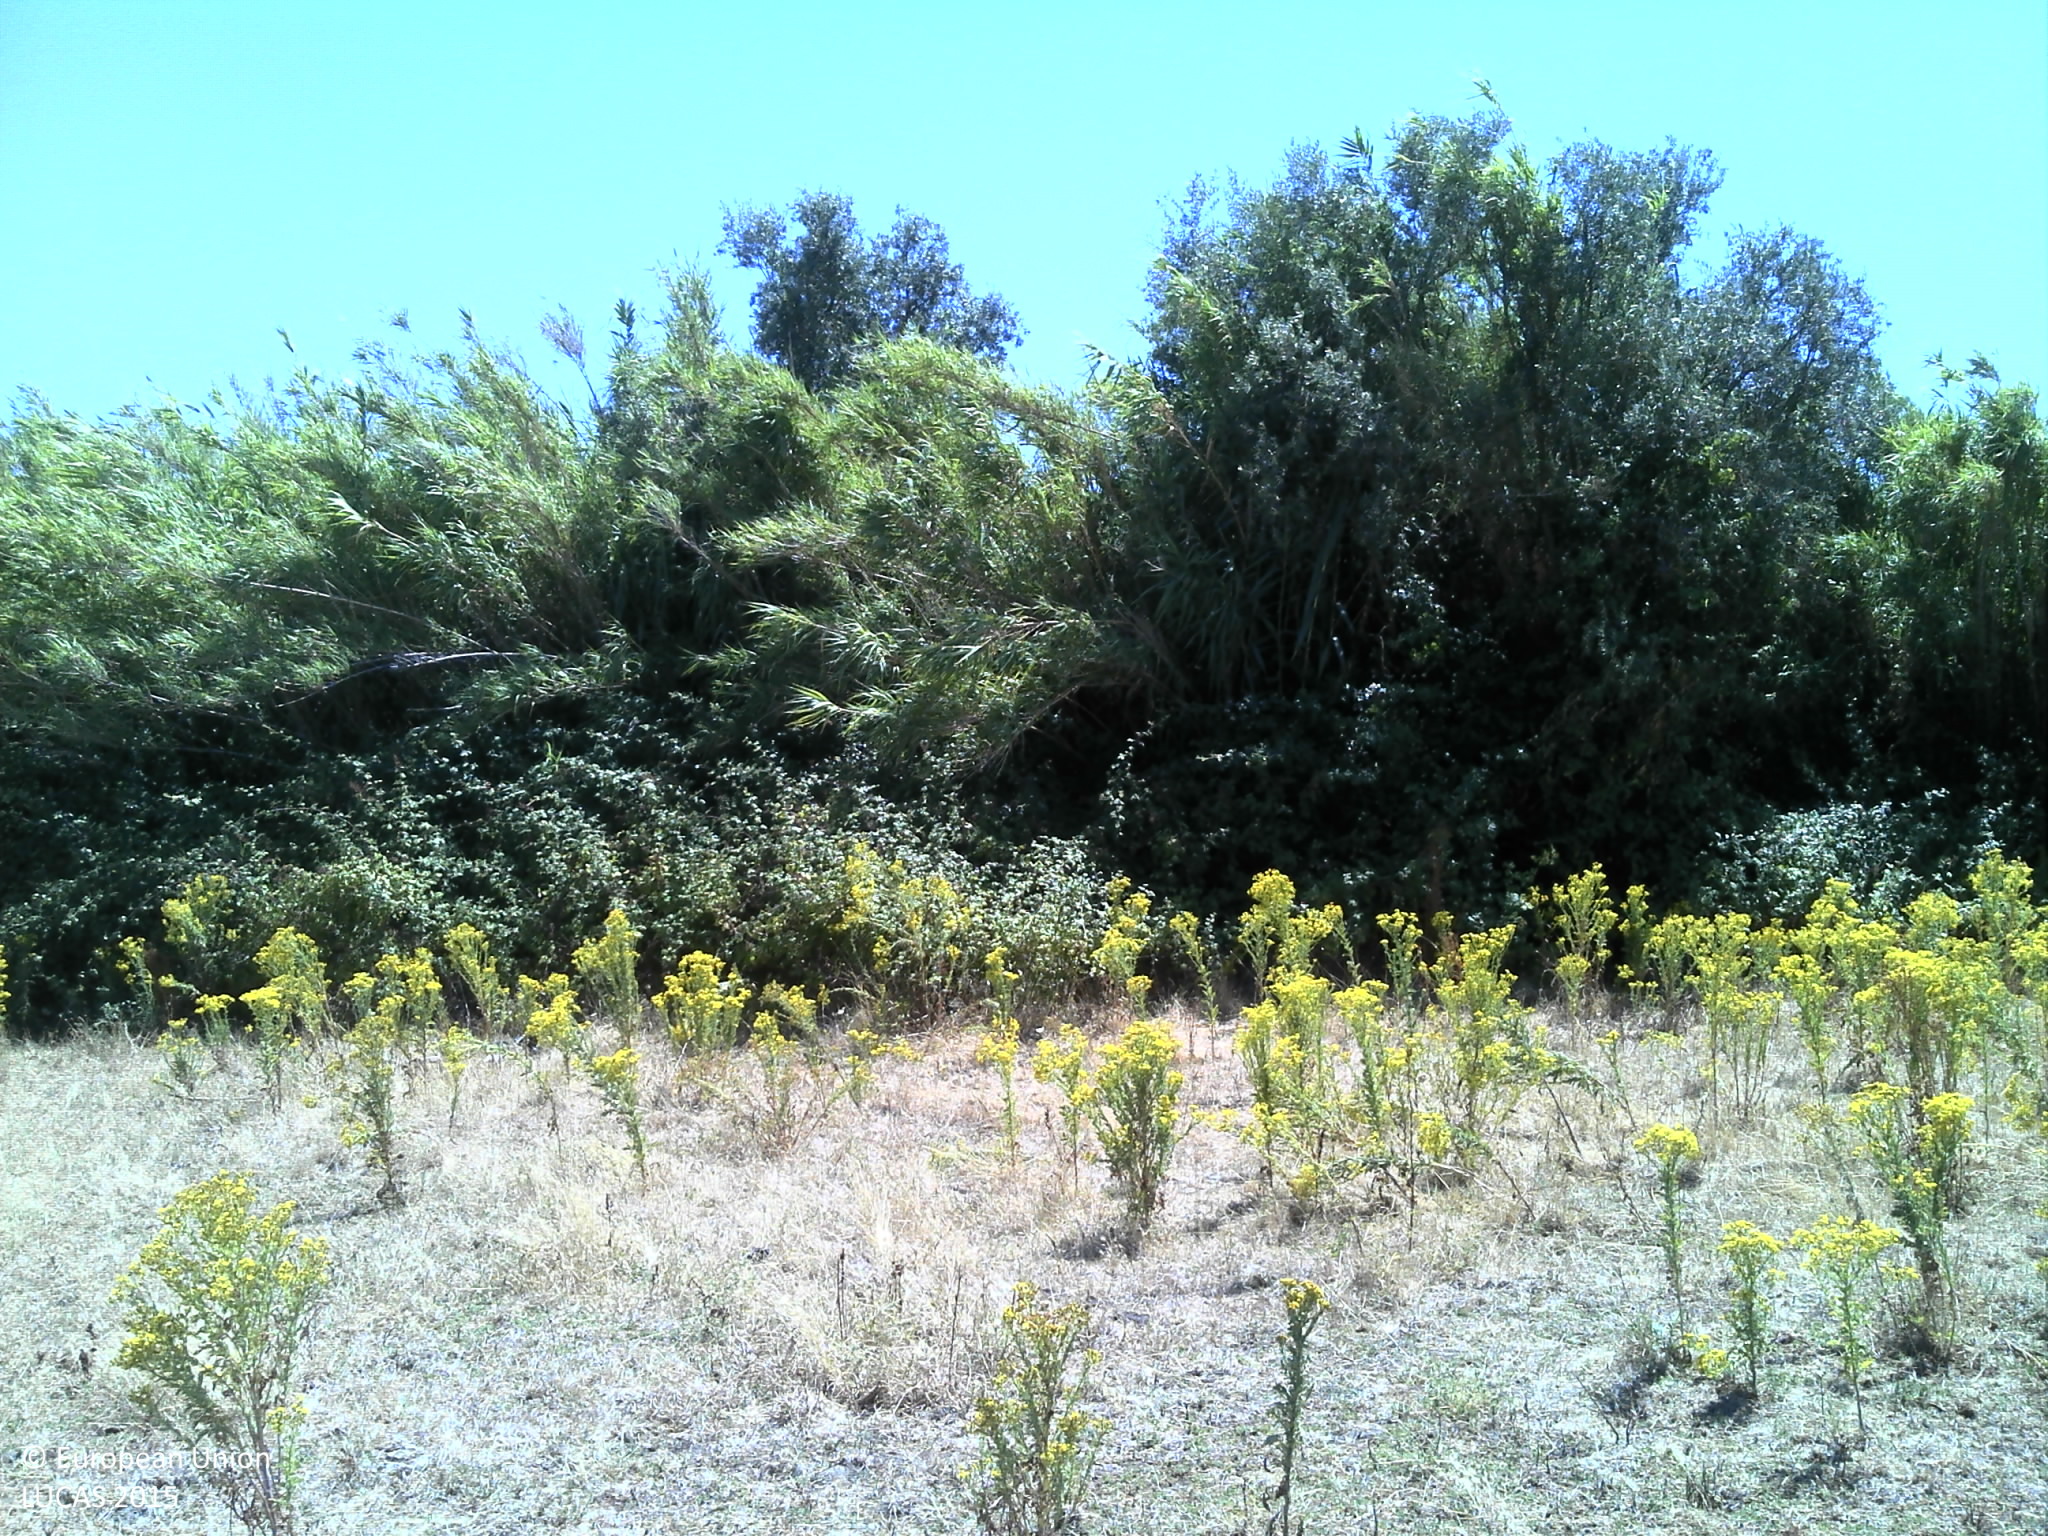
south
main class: Grassland
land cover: Grassland without tree/shrub cover
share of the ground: 25 - 50 %
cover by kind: unconsolidated bare surface 75 %, herbaceous plants 25 %
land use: Agriculture (excluding fallow land and kitchen gardens)
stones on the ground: < 10 %
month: July
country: PT
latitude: 38.9809
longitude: -7.5739
